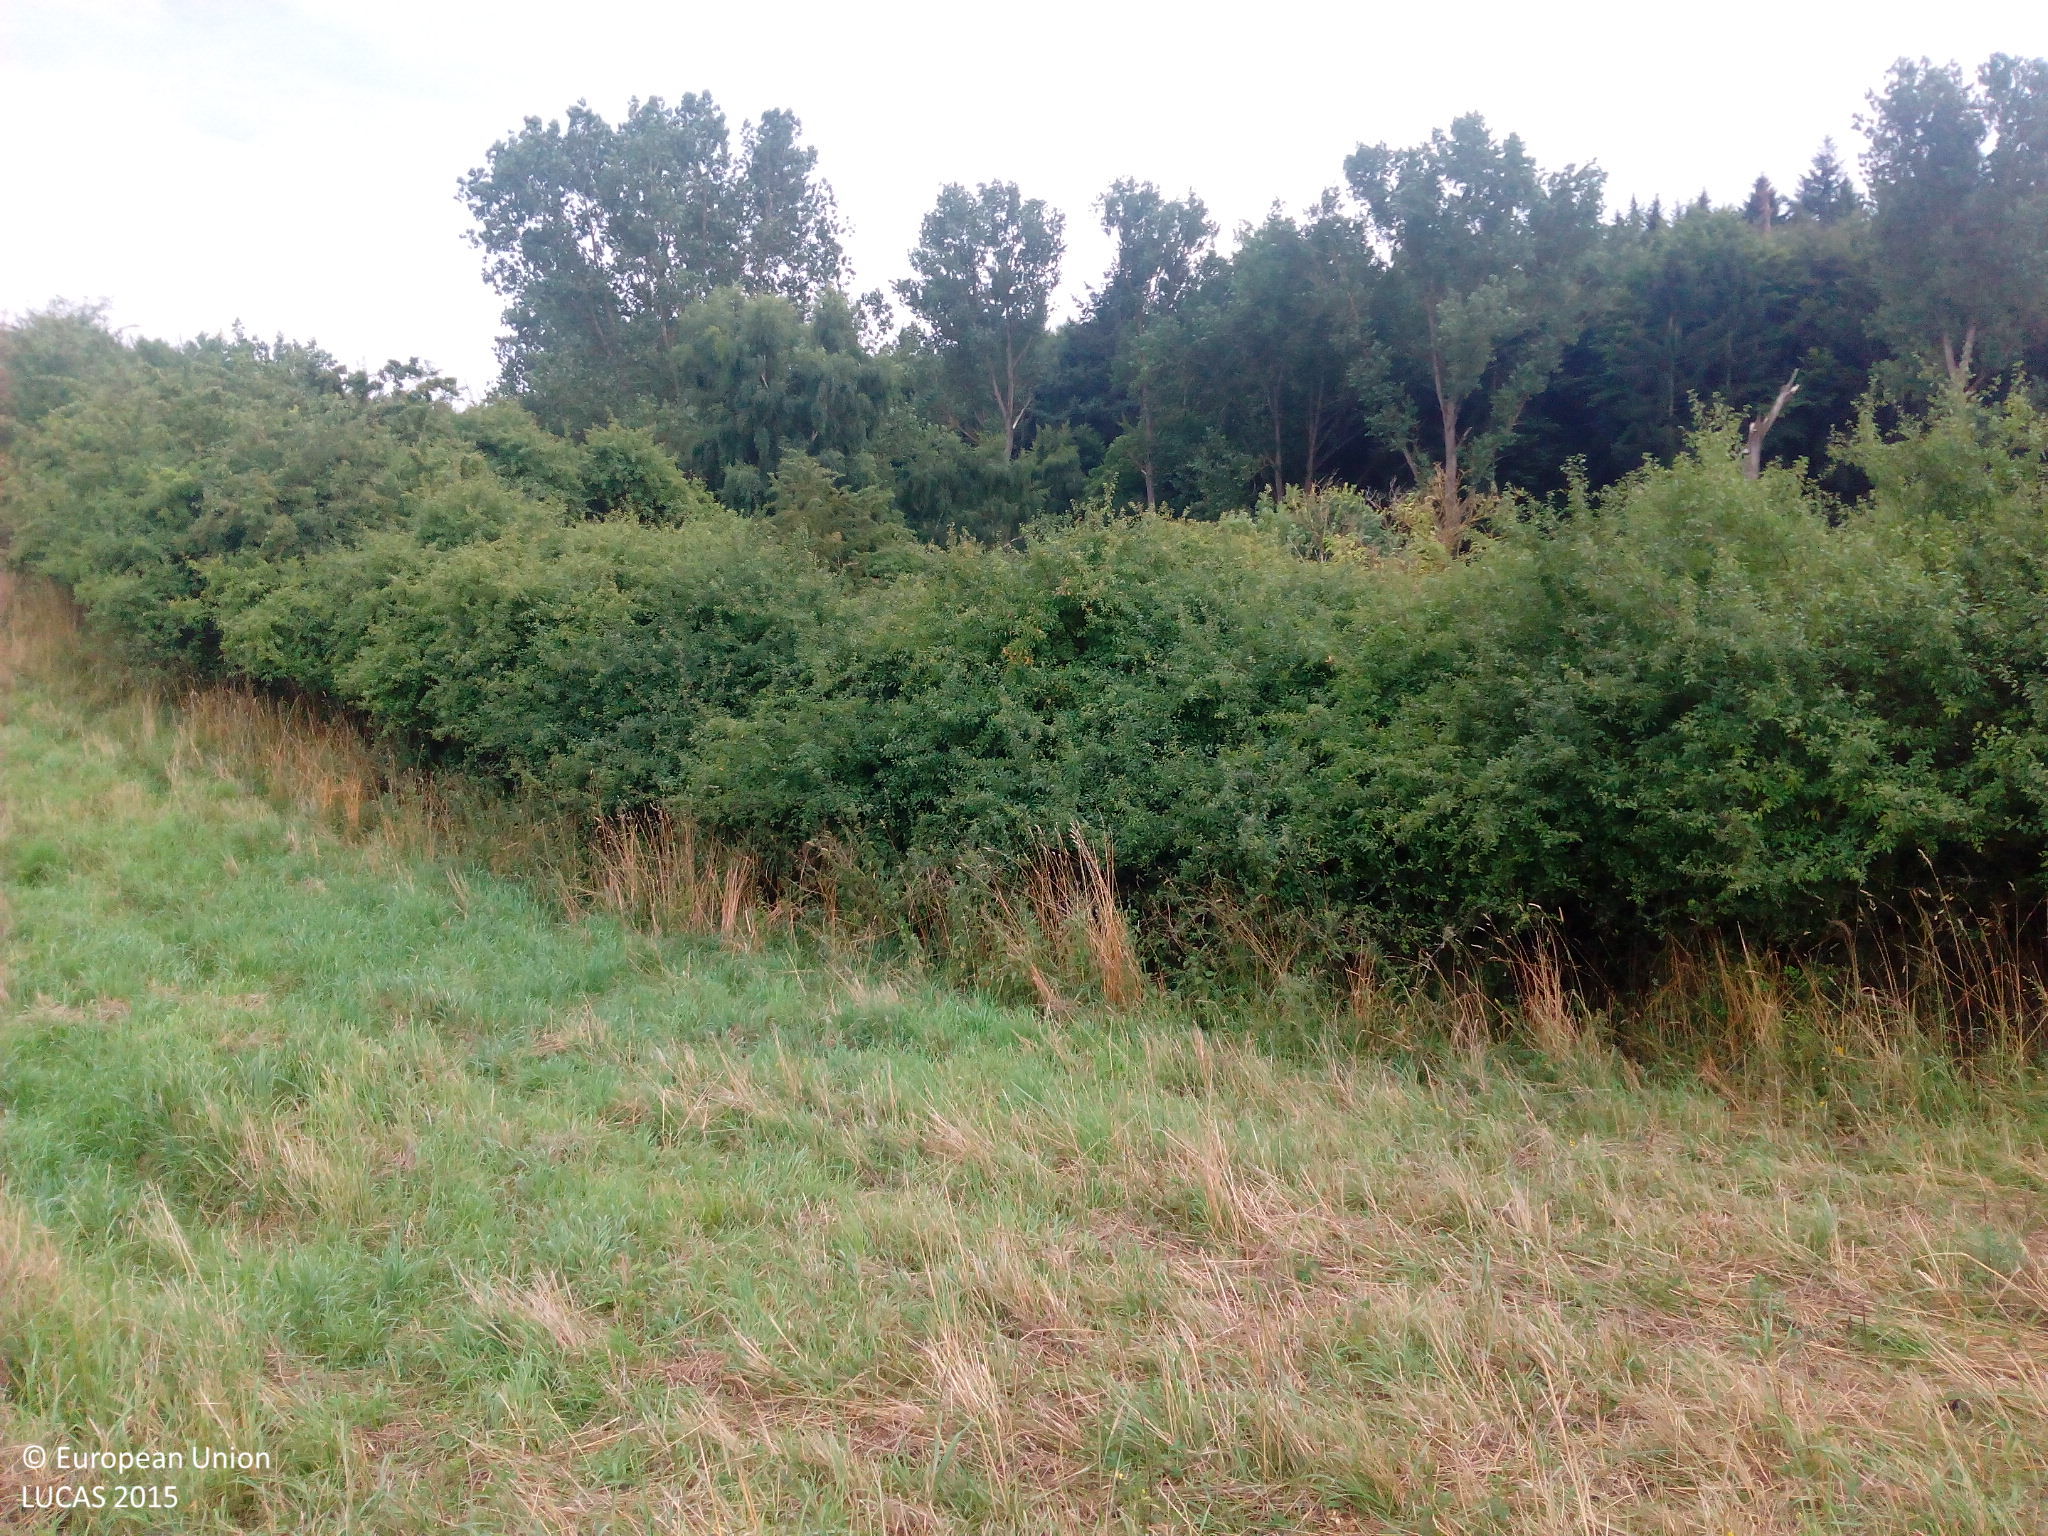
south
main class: Grassland
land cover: Grassland with sparse tree/shrub cover
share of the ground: > 75 %
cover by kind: herbaceous plants 95 %, broadleaved forest trees 5 %
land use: Agriculture (excluding fallow land and kitchen gardens)
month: August
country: DE
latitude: 53.6290
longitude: 13.2204
